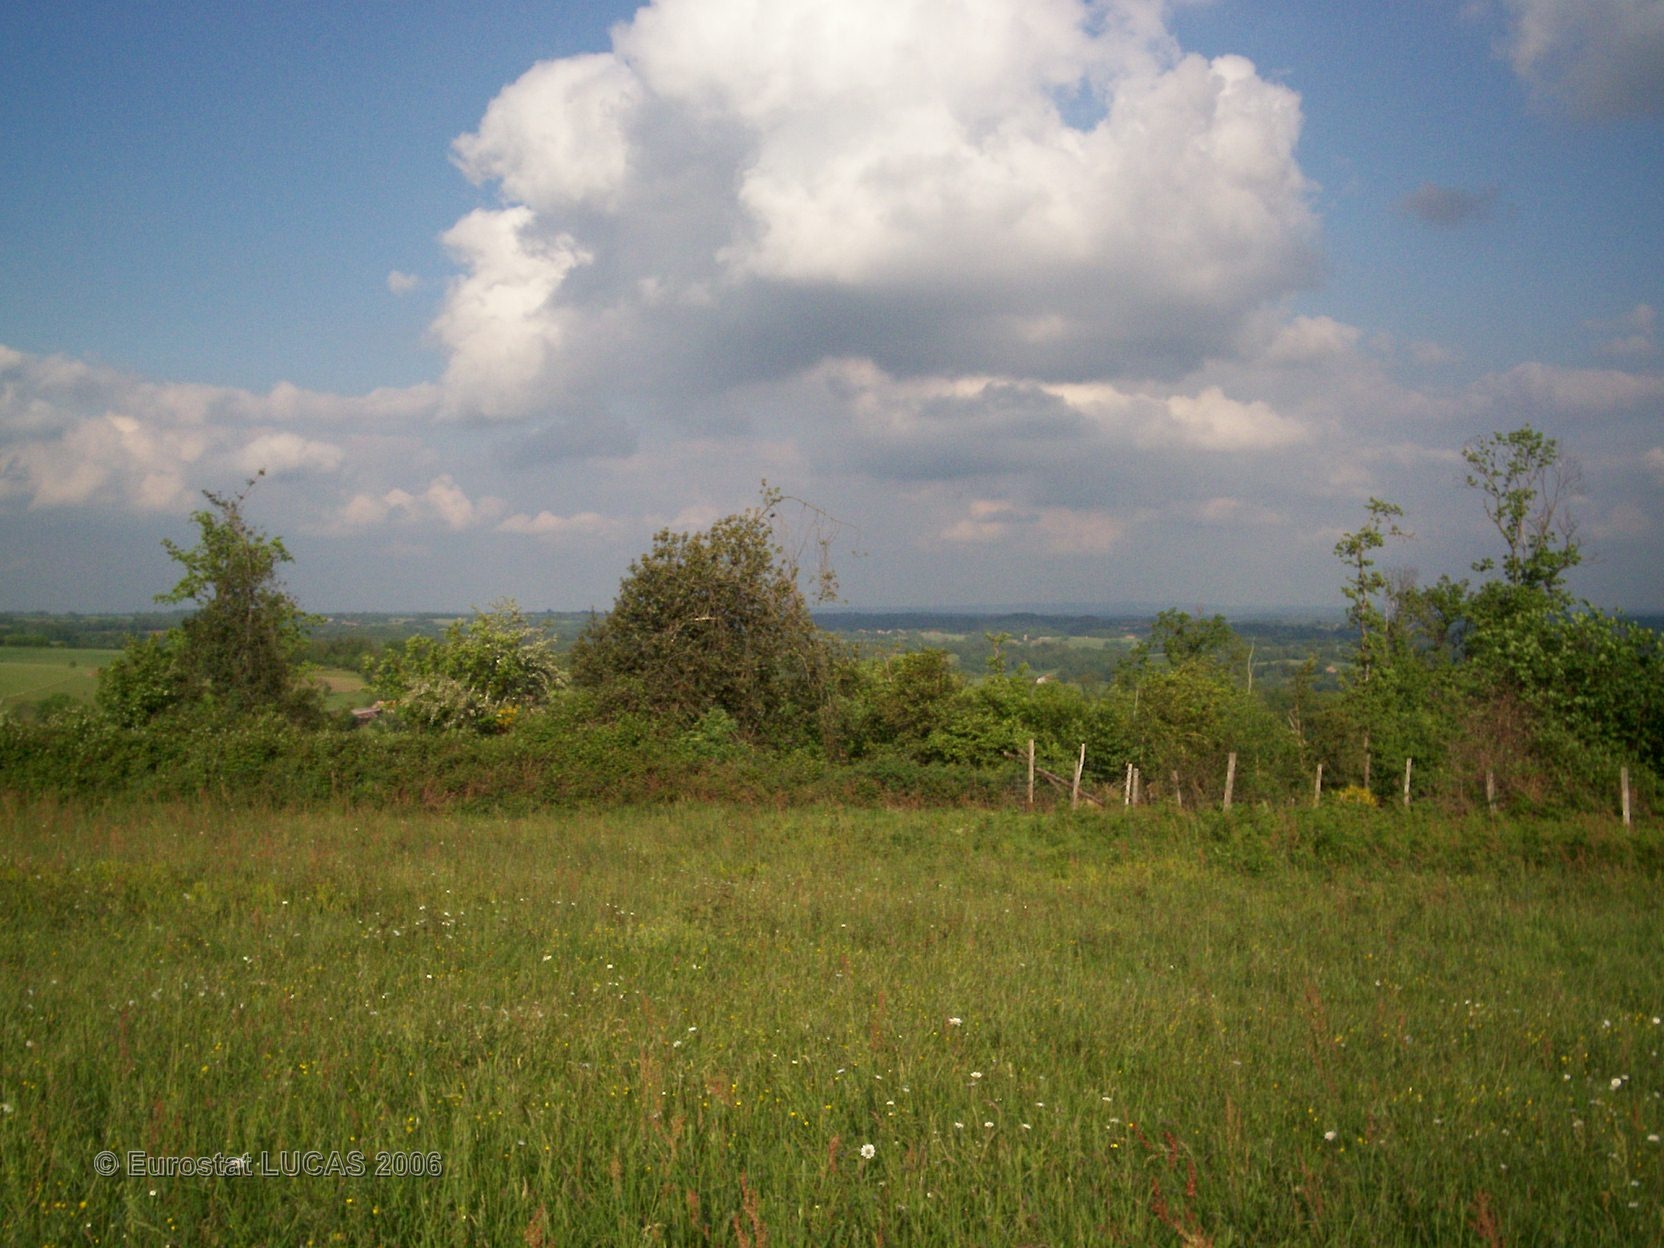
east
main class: Grassland
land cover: Grassland without tree/shrub cover
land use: Agriculture (excluding fallow land and kitchen gardens)
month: May
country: FR
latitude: 45.7093
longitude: 0.4933
